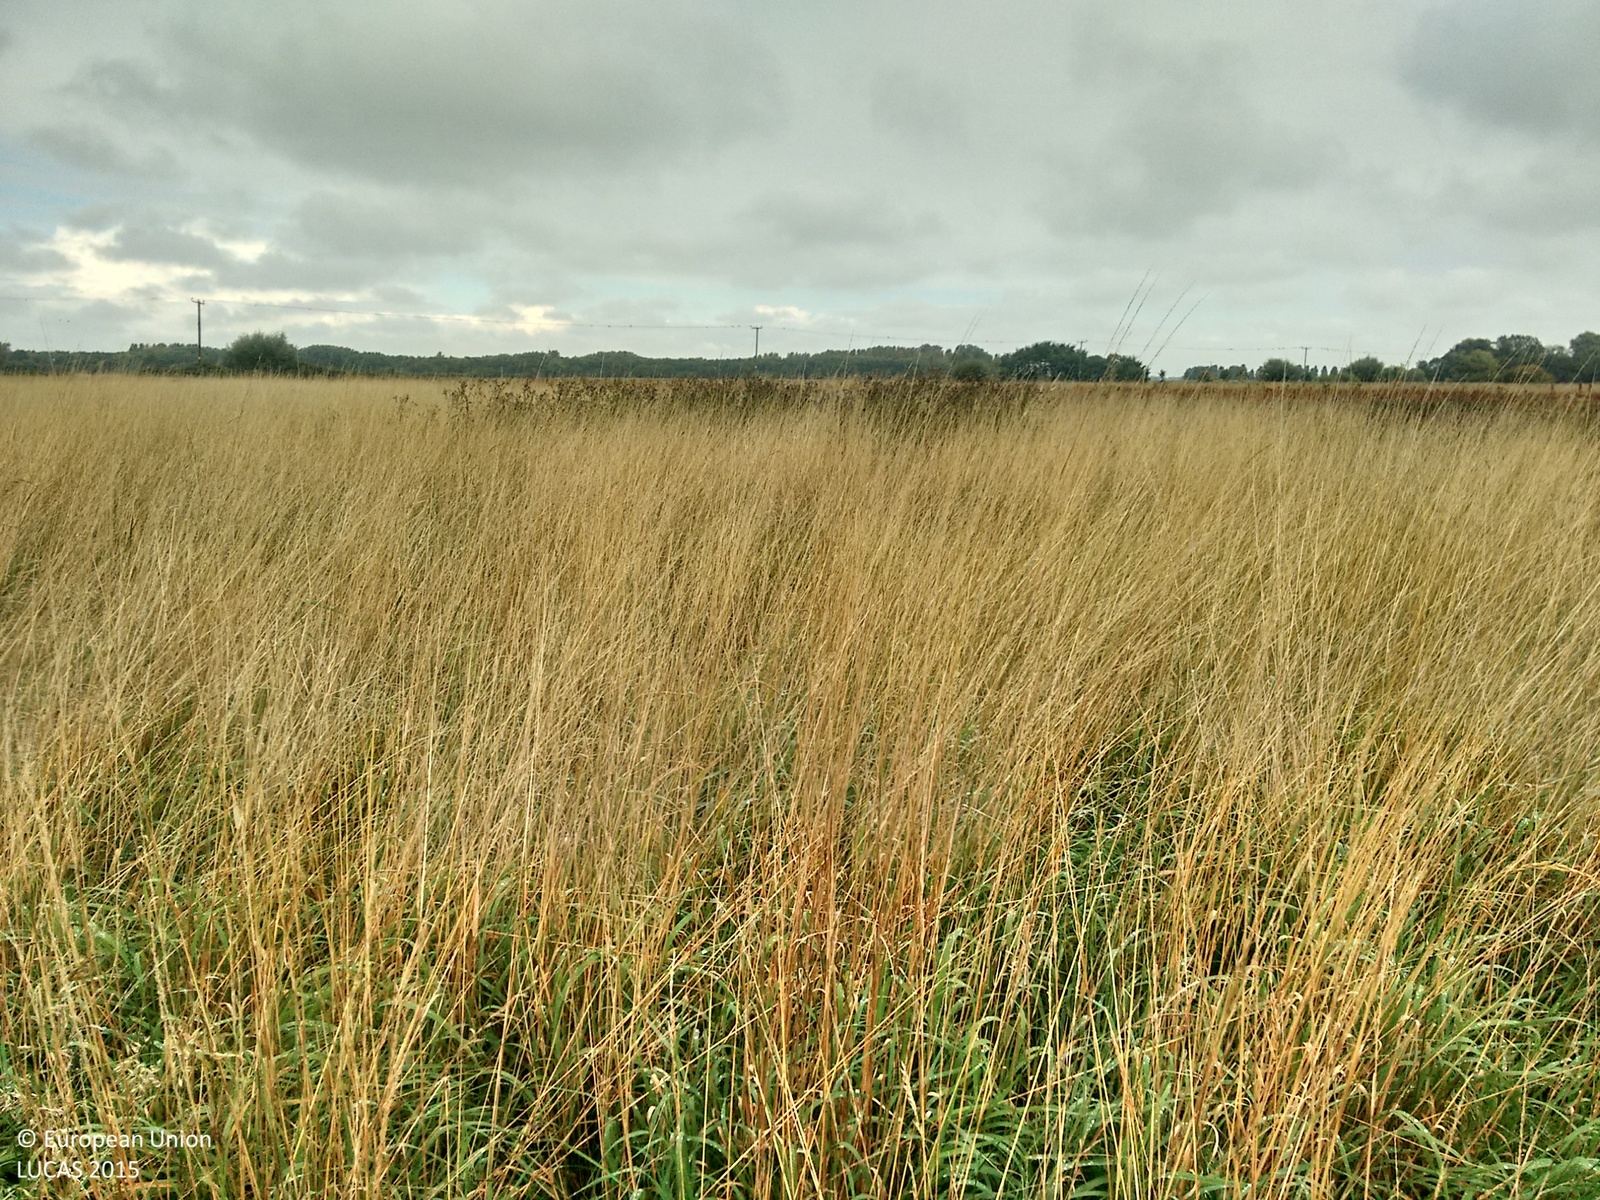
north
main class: Grassland
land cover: Grassland without tree/shrub cover
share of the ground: > 75 %
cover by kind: herbaceous plants 100 %
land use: Agriculture (excluding fallow land and kitchen gardens)
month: September
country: GB
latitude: 52.3171
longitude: 0.0066
